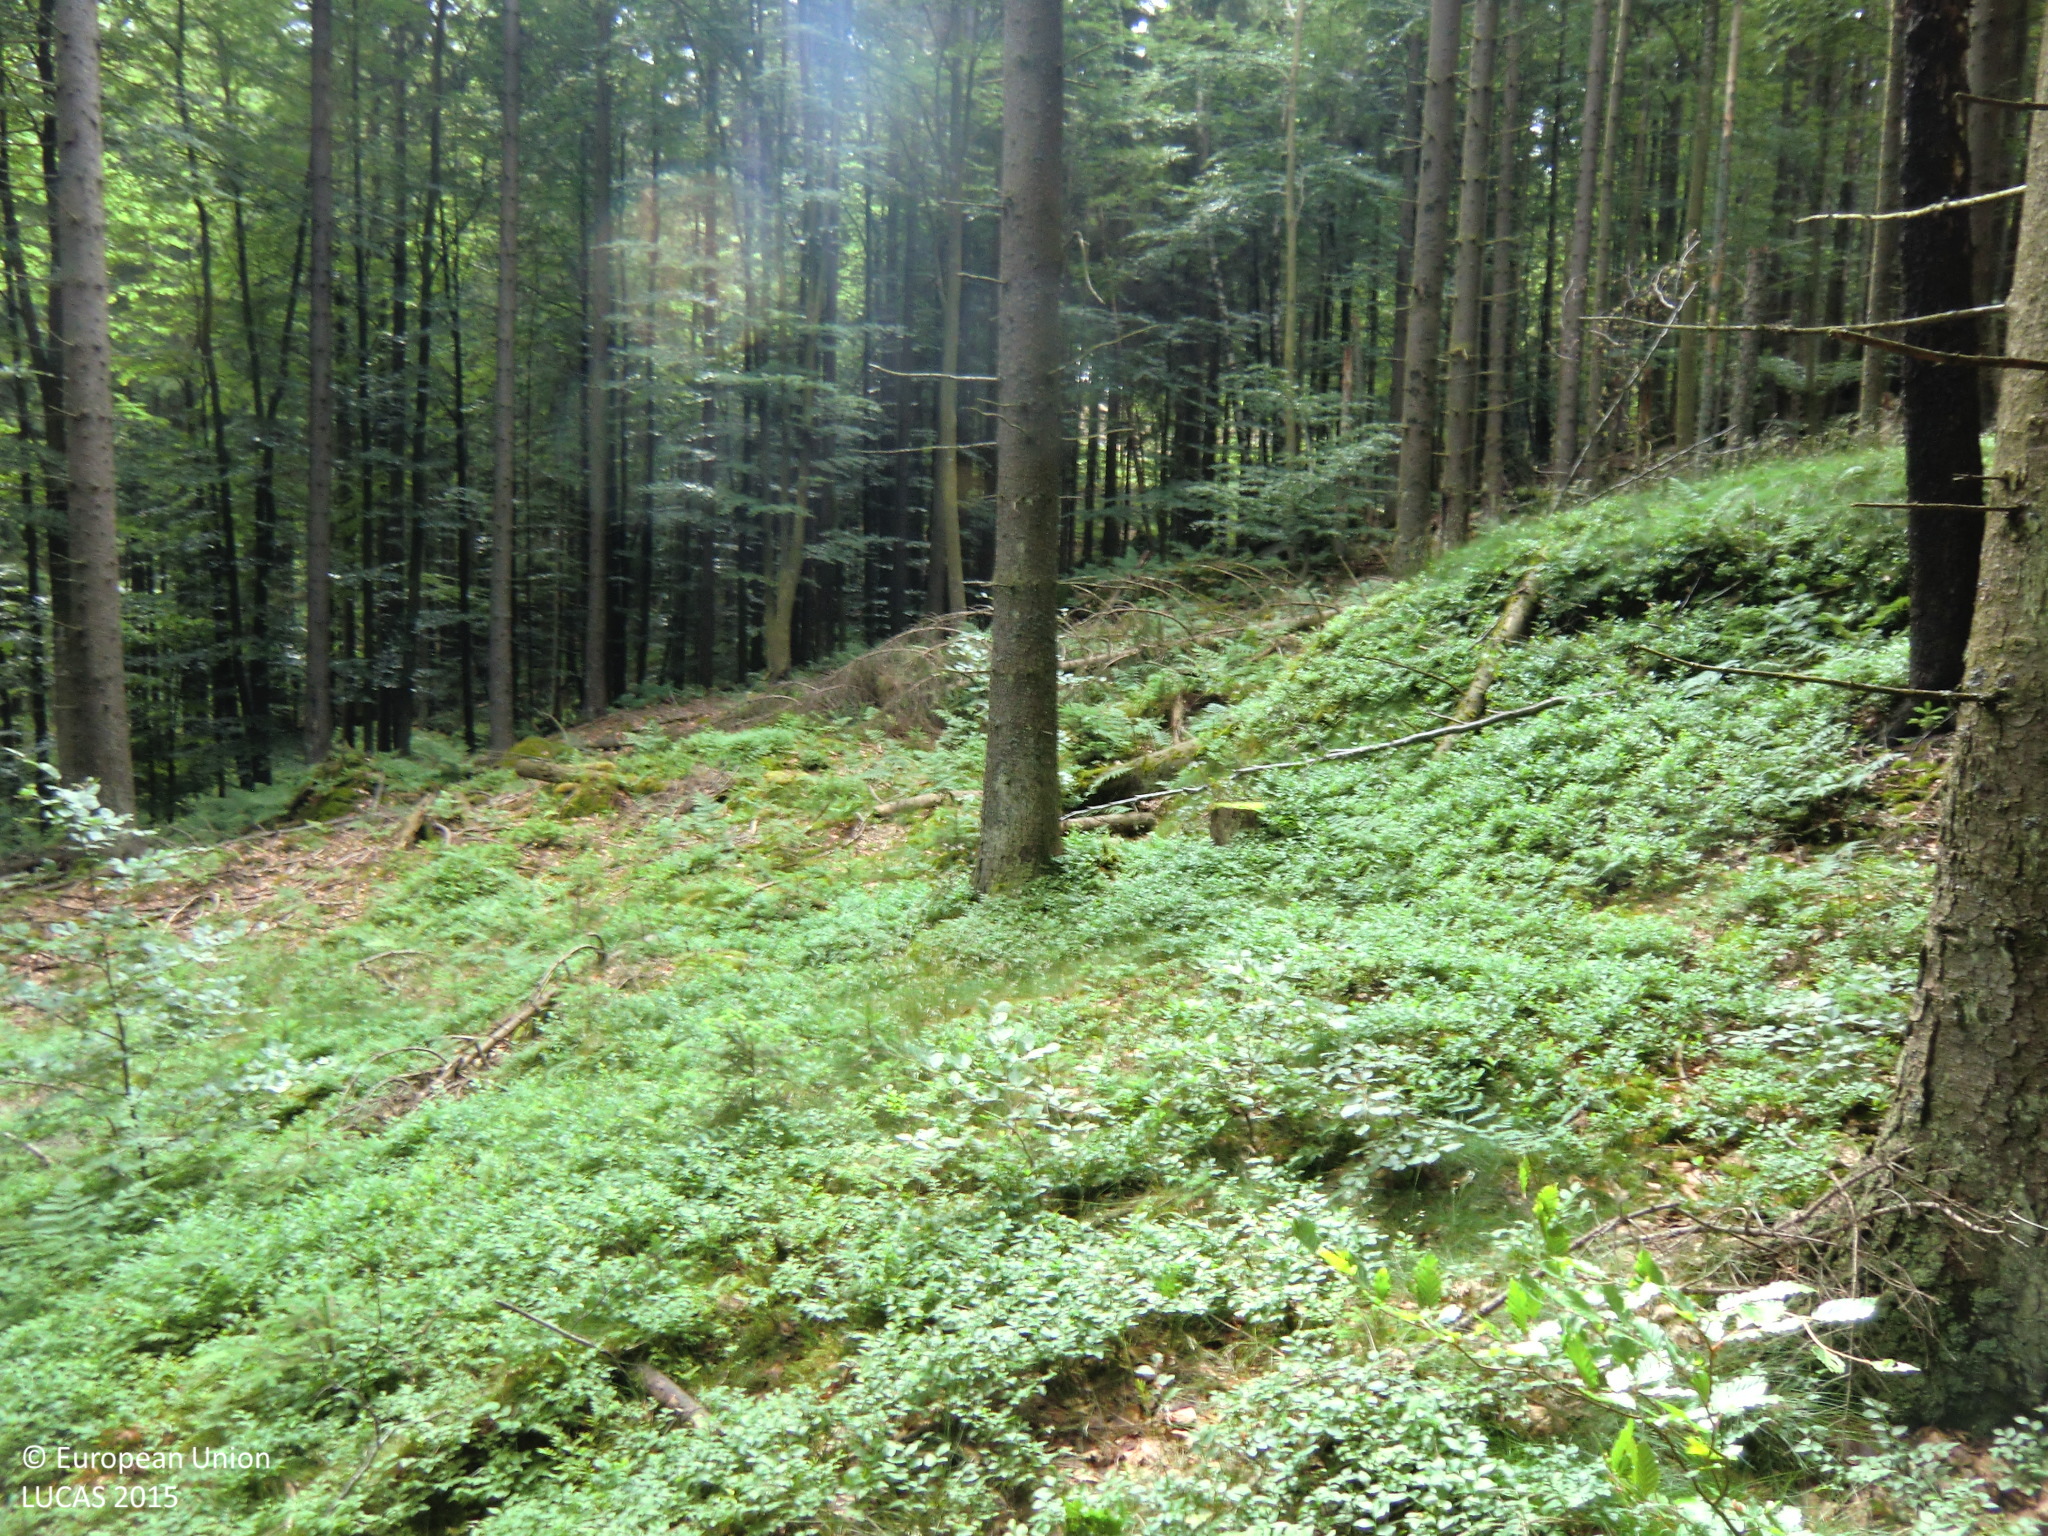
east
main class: Woodland
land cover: Spruce dominated mixed woodland
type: mountainous beech forest
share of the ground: > 75 %
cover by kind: coniferous forest trees 40 %, broadleaved forest trees 40 %, shrubs 10 %, herbaceous plants 5 %, unconsolidated bare surface 5 %
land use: Forestry
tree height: > 5 m
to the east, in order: Spruce dominated mixed woodland; Rivers and streams; Spruce dominated mixed woodland; Rivers and streams; Spruce dominated mixed woodland; Tracks; Spruce dominated mixed woodland; Broadleaved woodland; Tracks; Spruce dominated mixed woodland
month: June
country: AT
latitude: 48.3250
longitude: 15.0322
